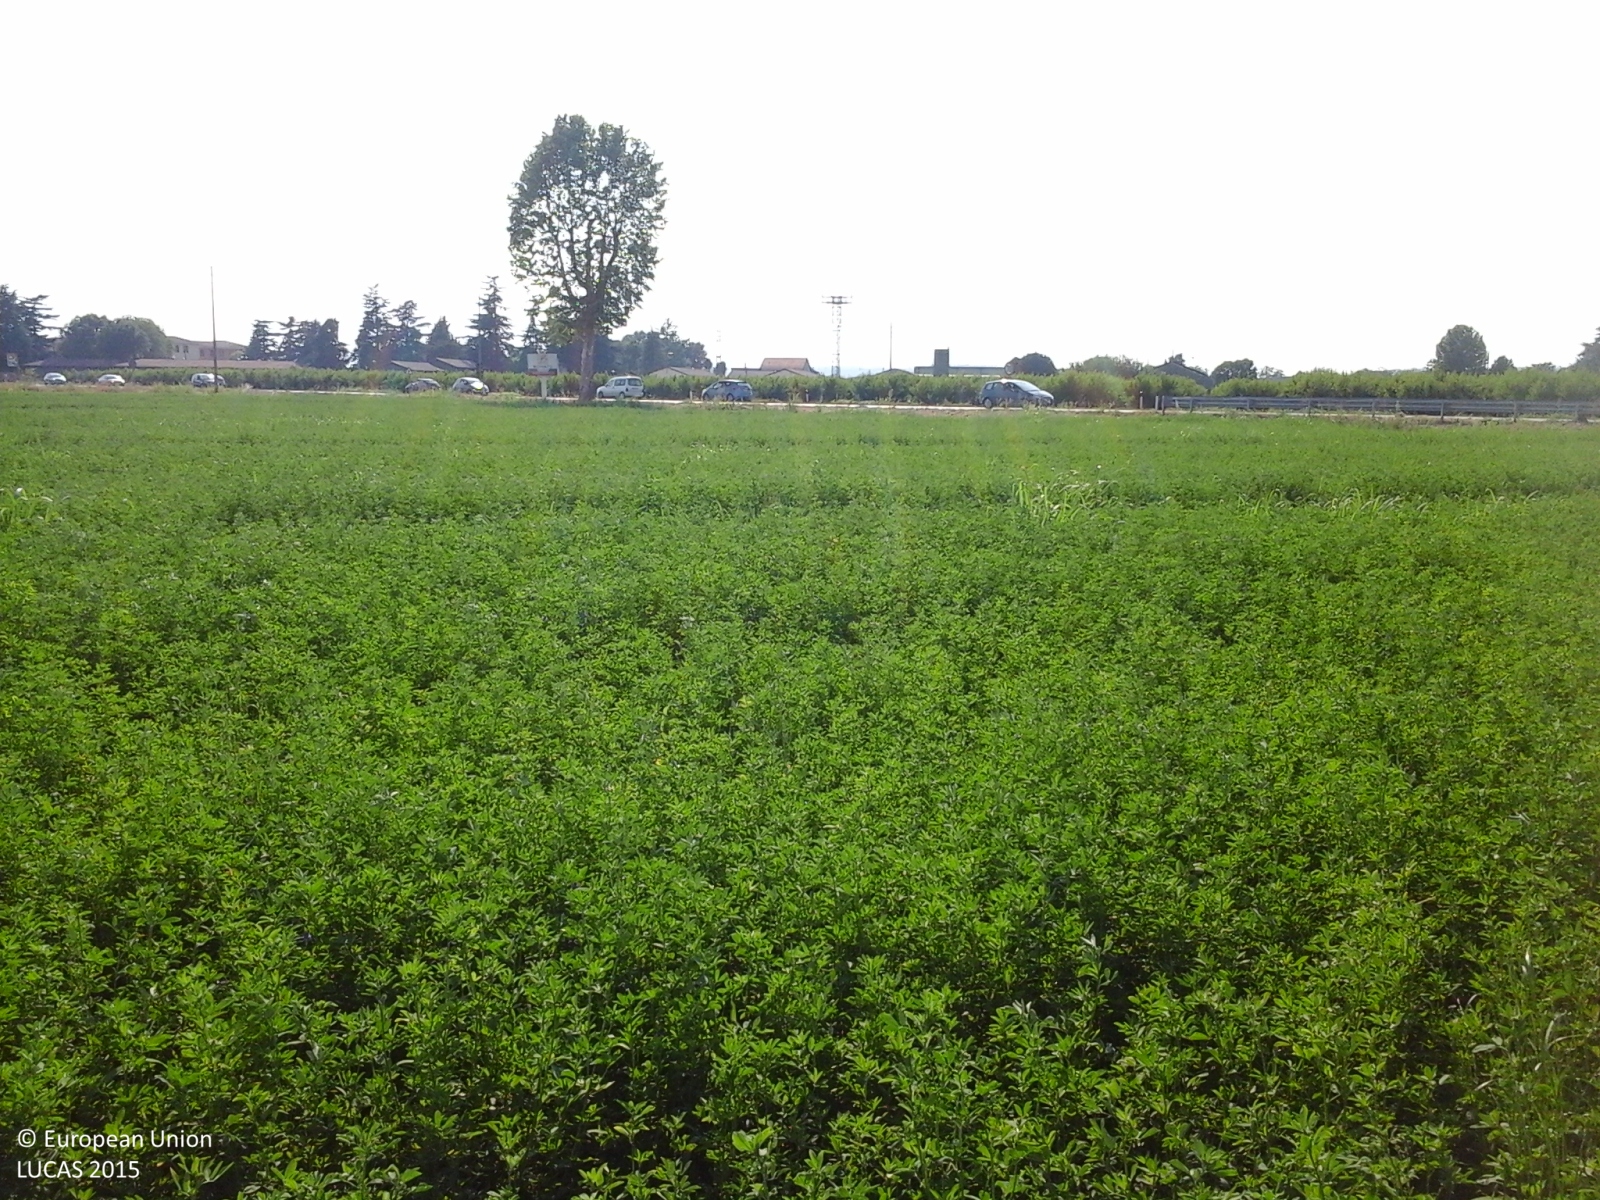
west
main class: Cropland
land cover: Lucerne
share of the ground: > 75 %
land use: Agriculture (excluding fallow land and kitchen gardens)
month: July
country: IT
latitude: 45.3746
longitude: 10.8795
